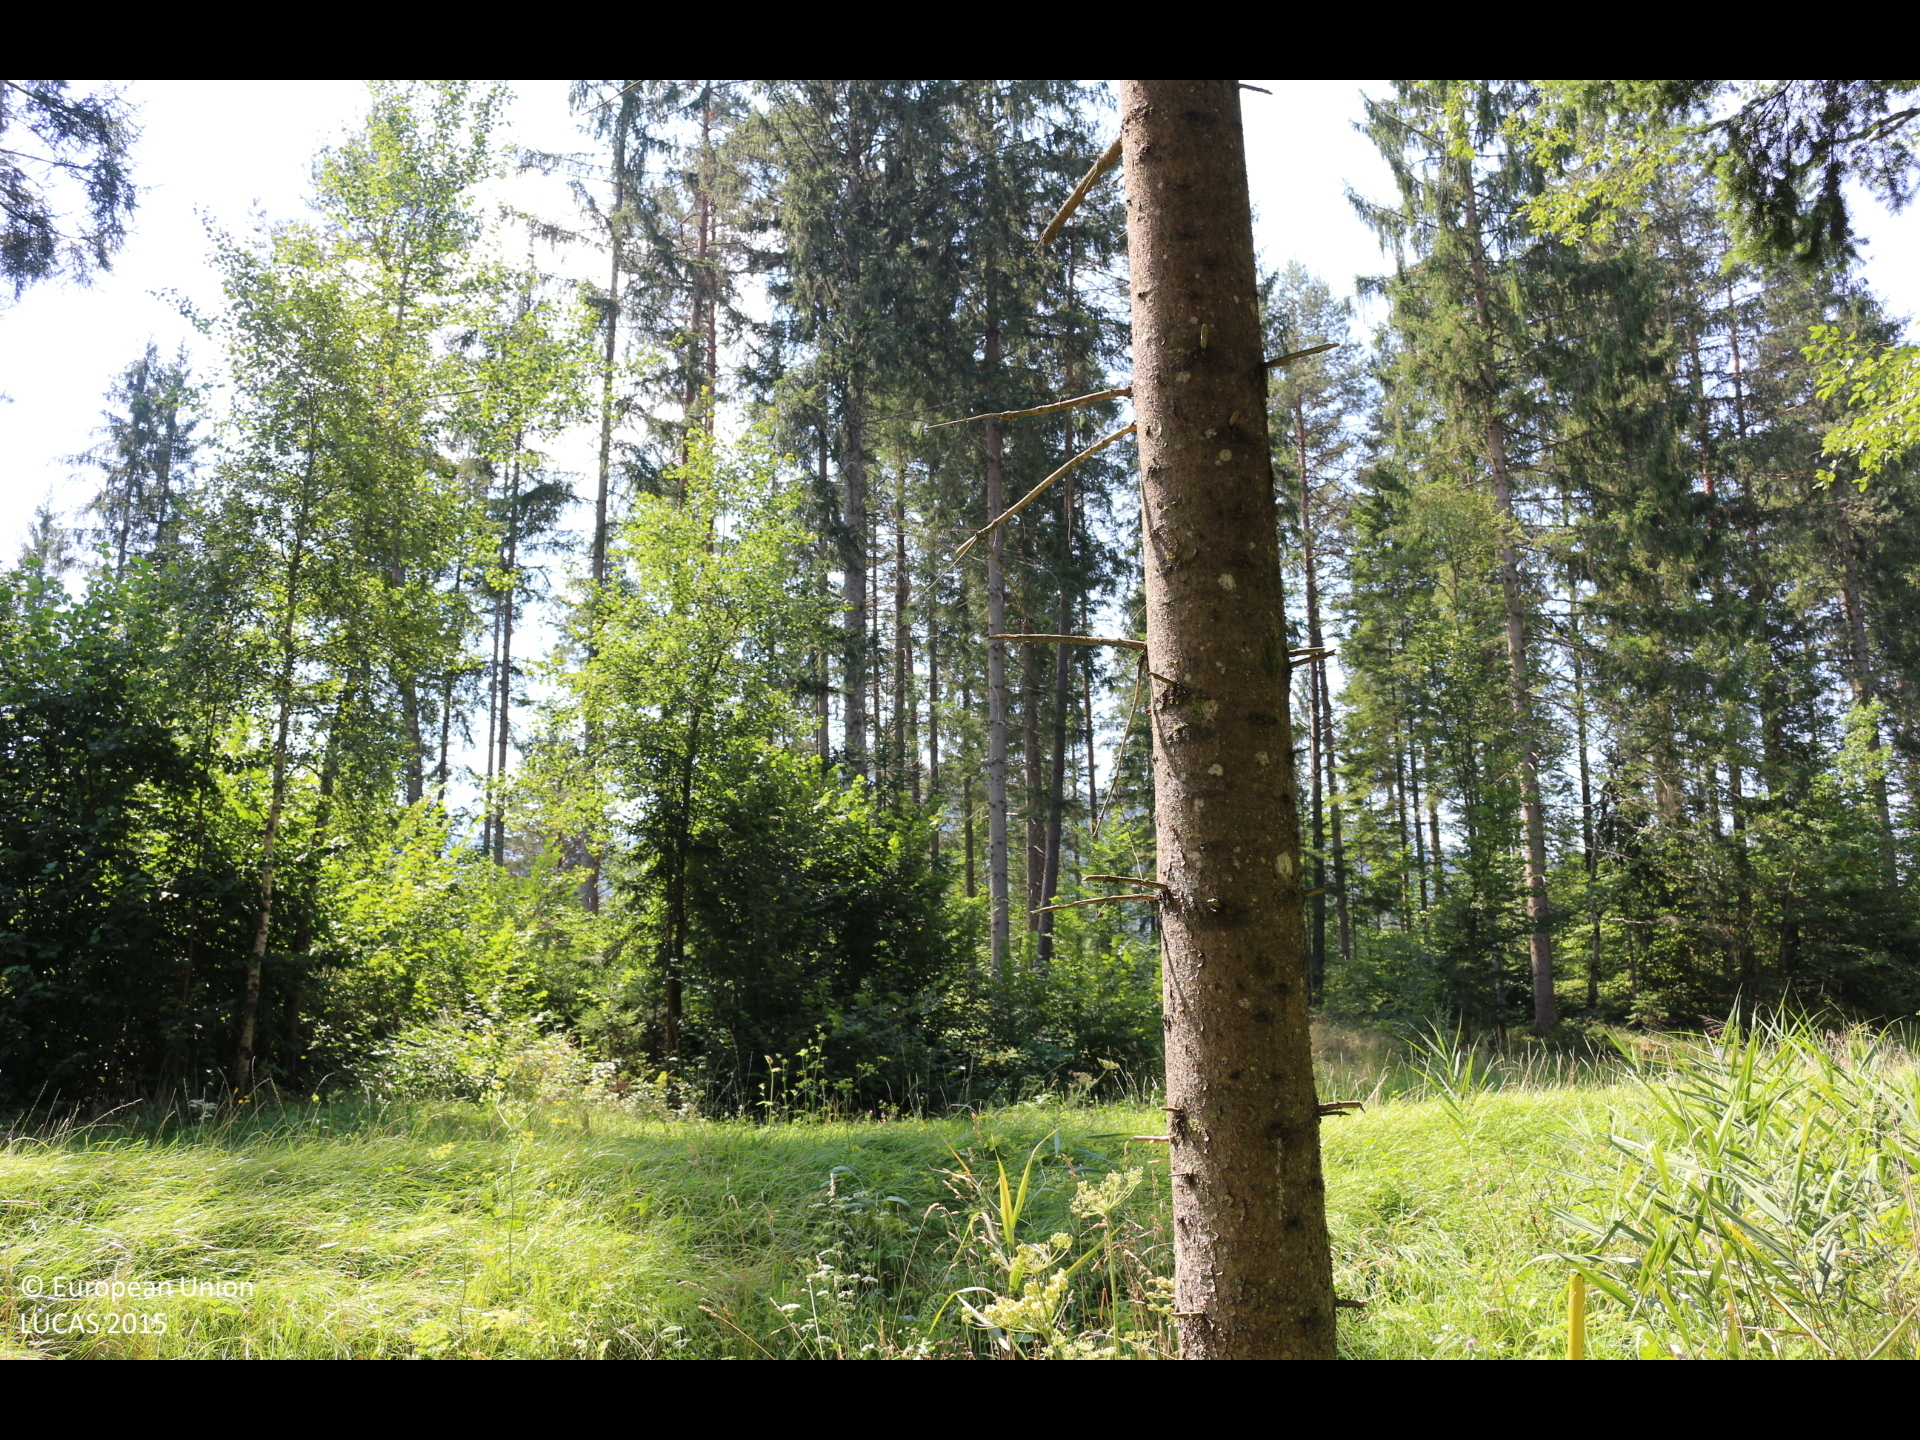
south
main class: Woodland
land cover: Spruce dominated coniferous woodland
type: alpine coniferous forest
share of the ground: > 75 %
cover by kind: coniferous forest trees 80 %, herbaceous plants 15 %, broadleaved forest trees 5 %
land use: Forestry
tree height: > 5 m
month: August
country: AT
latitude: 46.8486
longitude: 14.1287
